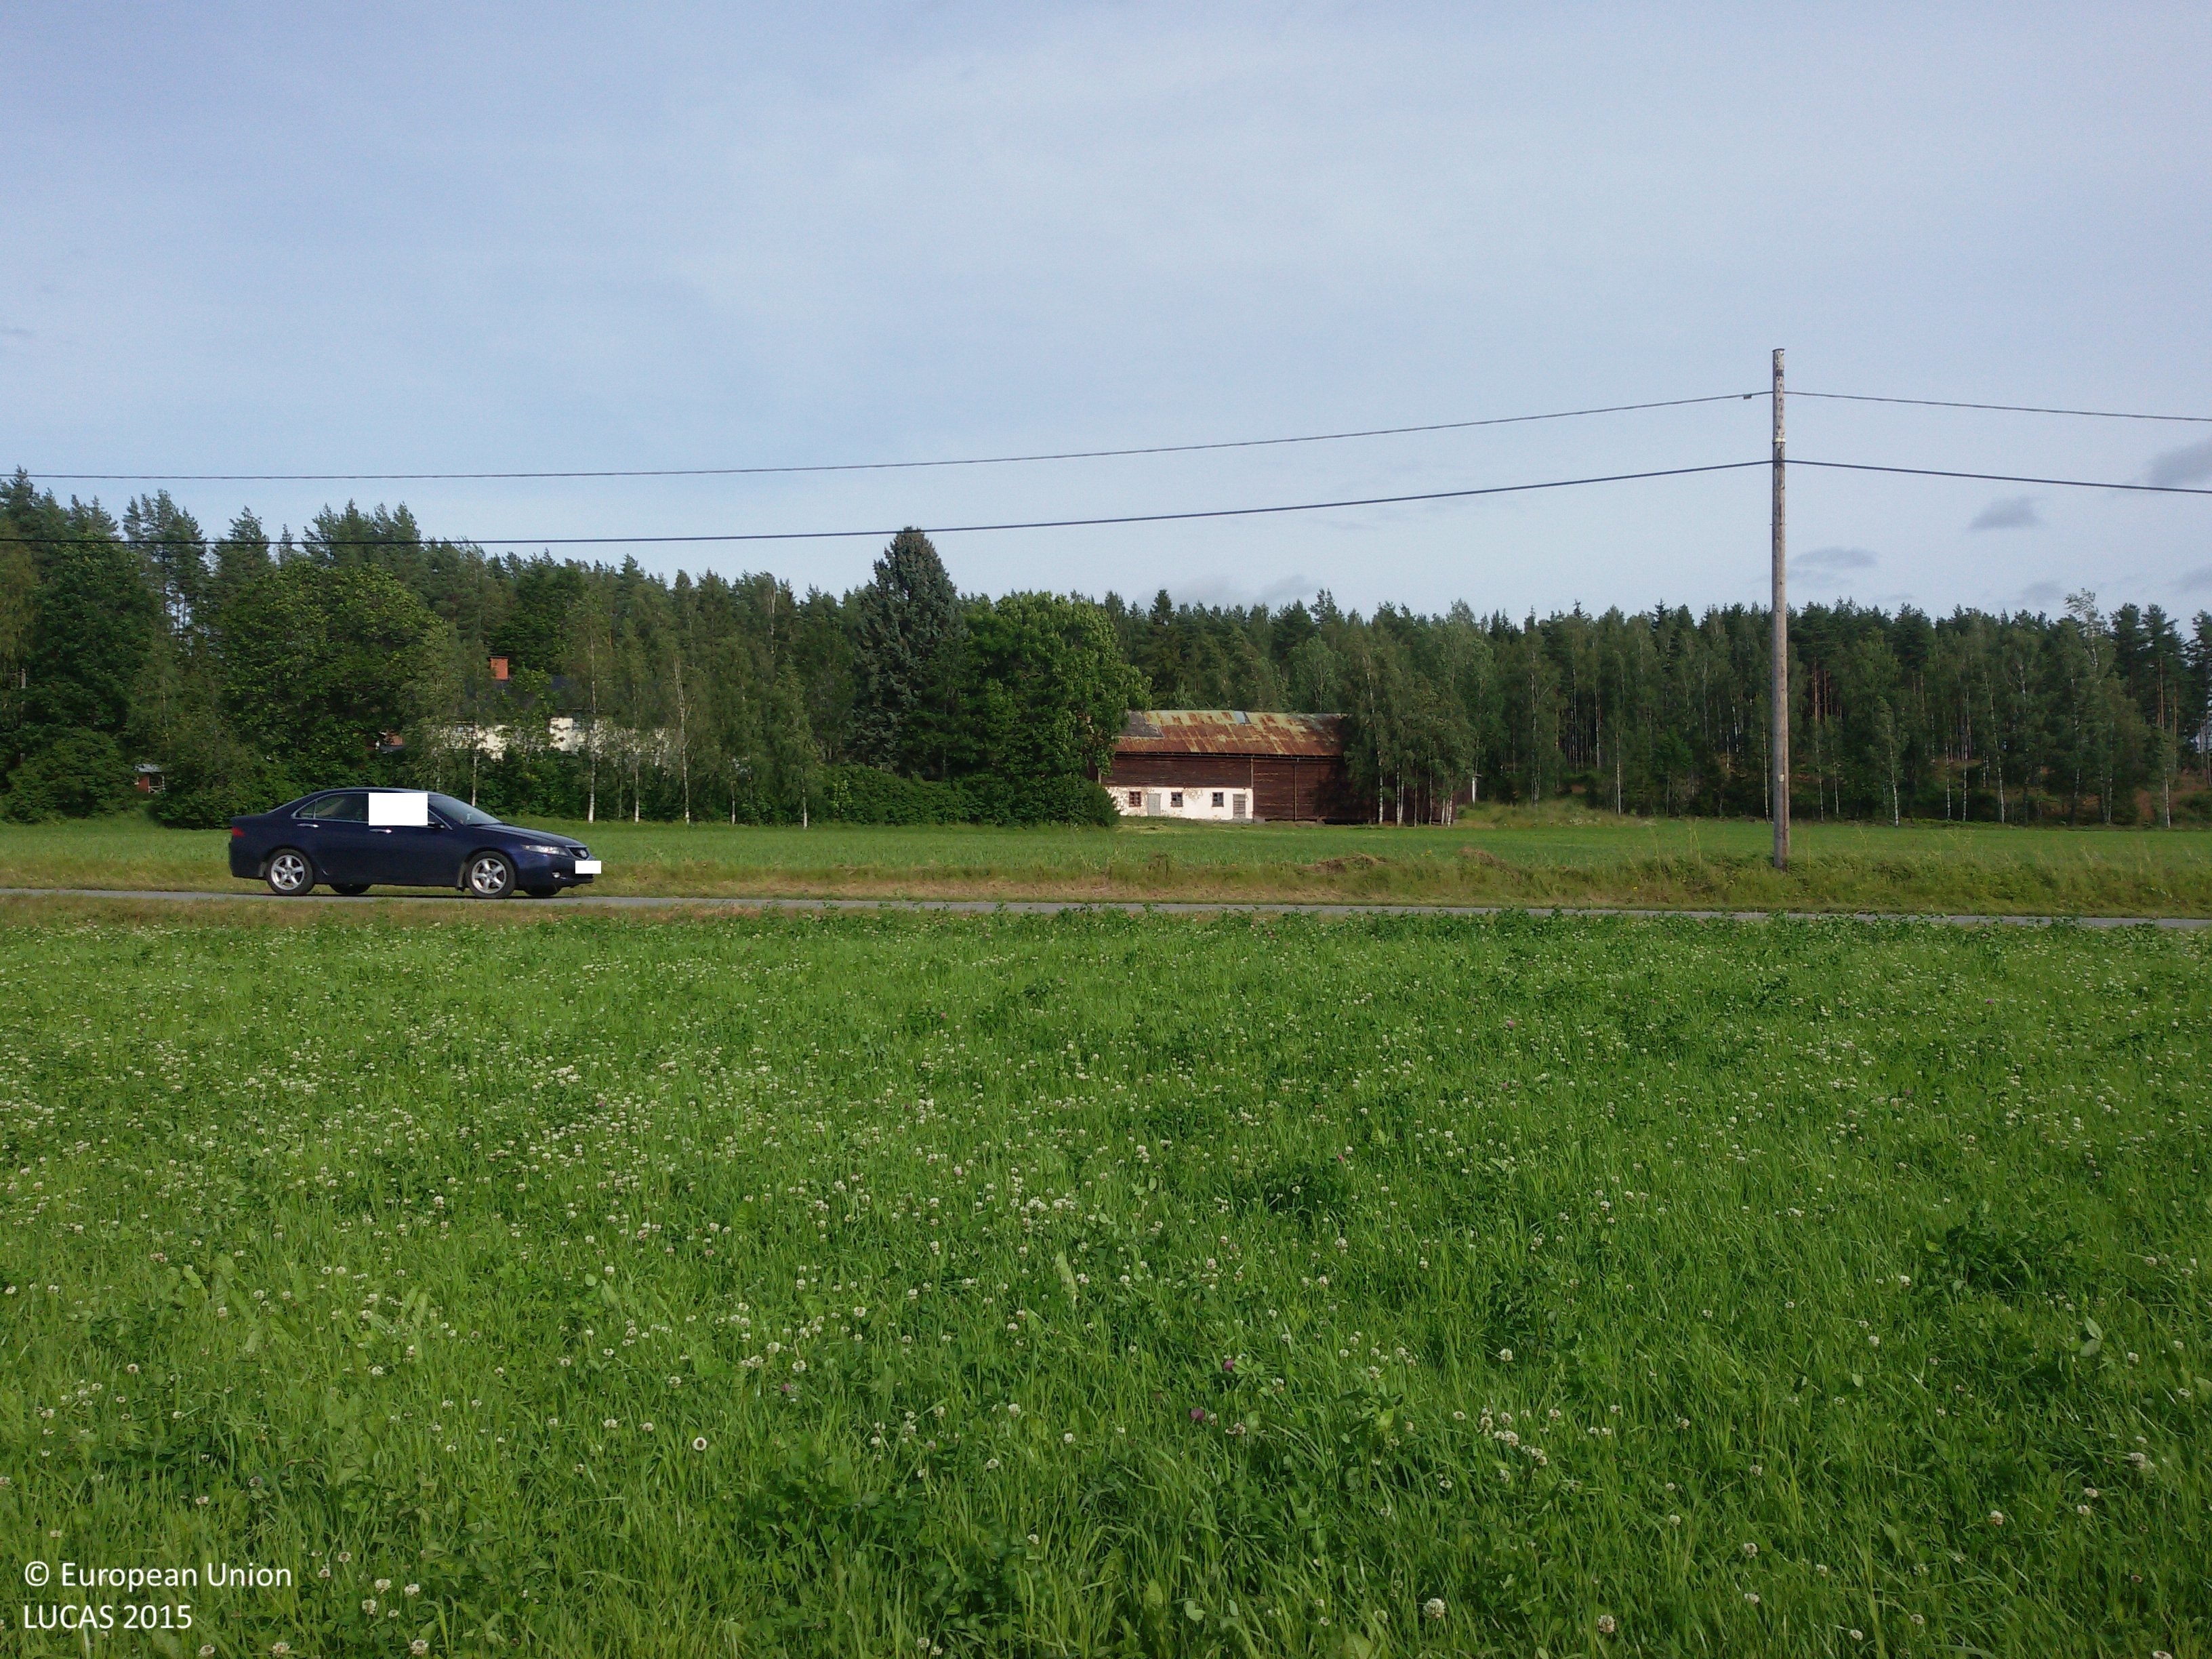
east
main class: Cropland
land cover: Other leguminous and mixtures for fodder
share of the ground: > 75 %
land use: Agriculture (excluding fallow land and kitchen gardens)
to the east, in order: Other leguminous and mixtures for fodder; Ditches and canals; Paved roads, cycling and walking lanes; Ditches and canals; Electric lines; Grassland without tree/shrub cover; Abandoned hedges; Artificial constructions in urban areas; Tracks; Grassland without tree/shrub cover; Spruce dominated mixed woodland
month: July
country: SE
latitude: 60.4233
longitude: 15.7820
